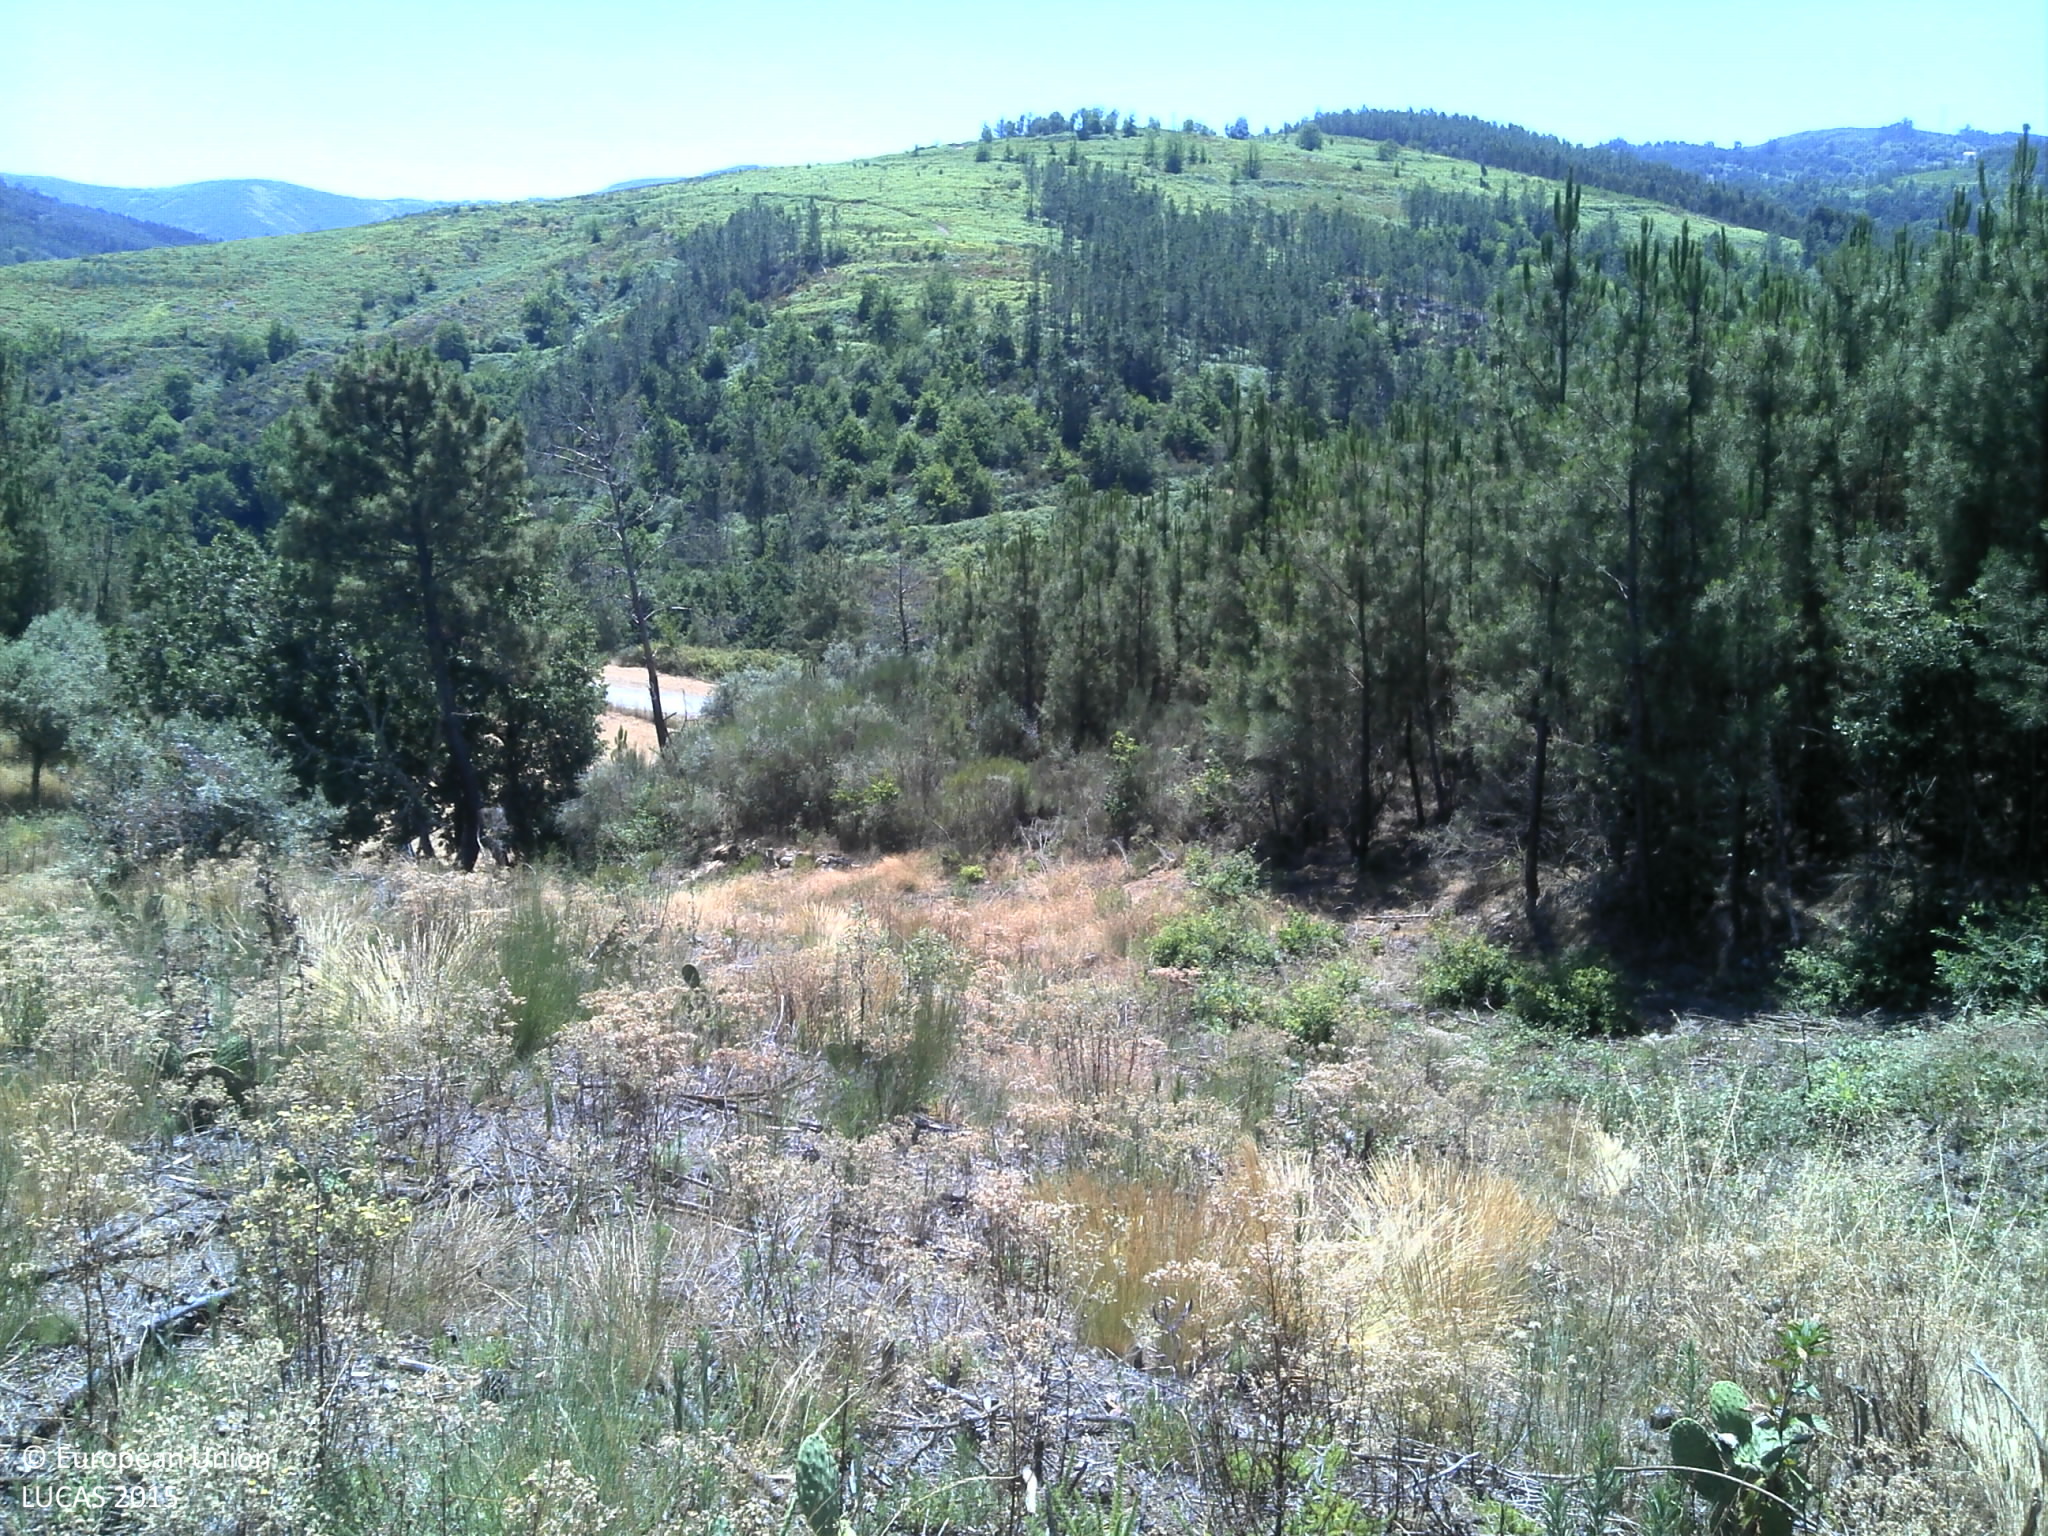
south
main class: Shrubland
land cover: Shrubland without tree cover
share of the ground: 50 - 75 %
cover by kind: shrubs 70 %, unconsolidated bare surface 20 %, herbaceous plants 10 %
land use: Agriculture (excluding fallow land and kitchen gardens)
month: July
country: PT
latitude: 40.2584
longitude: -7.9550
